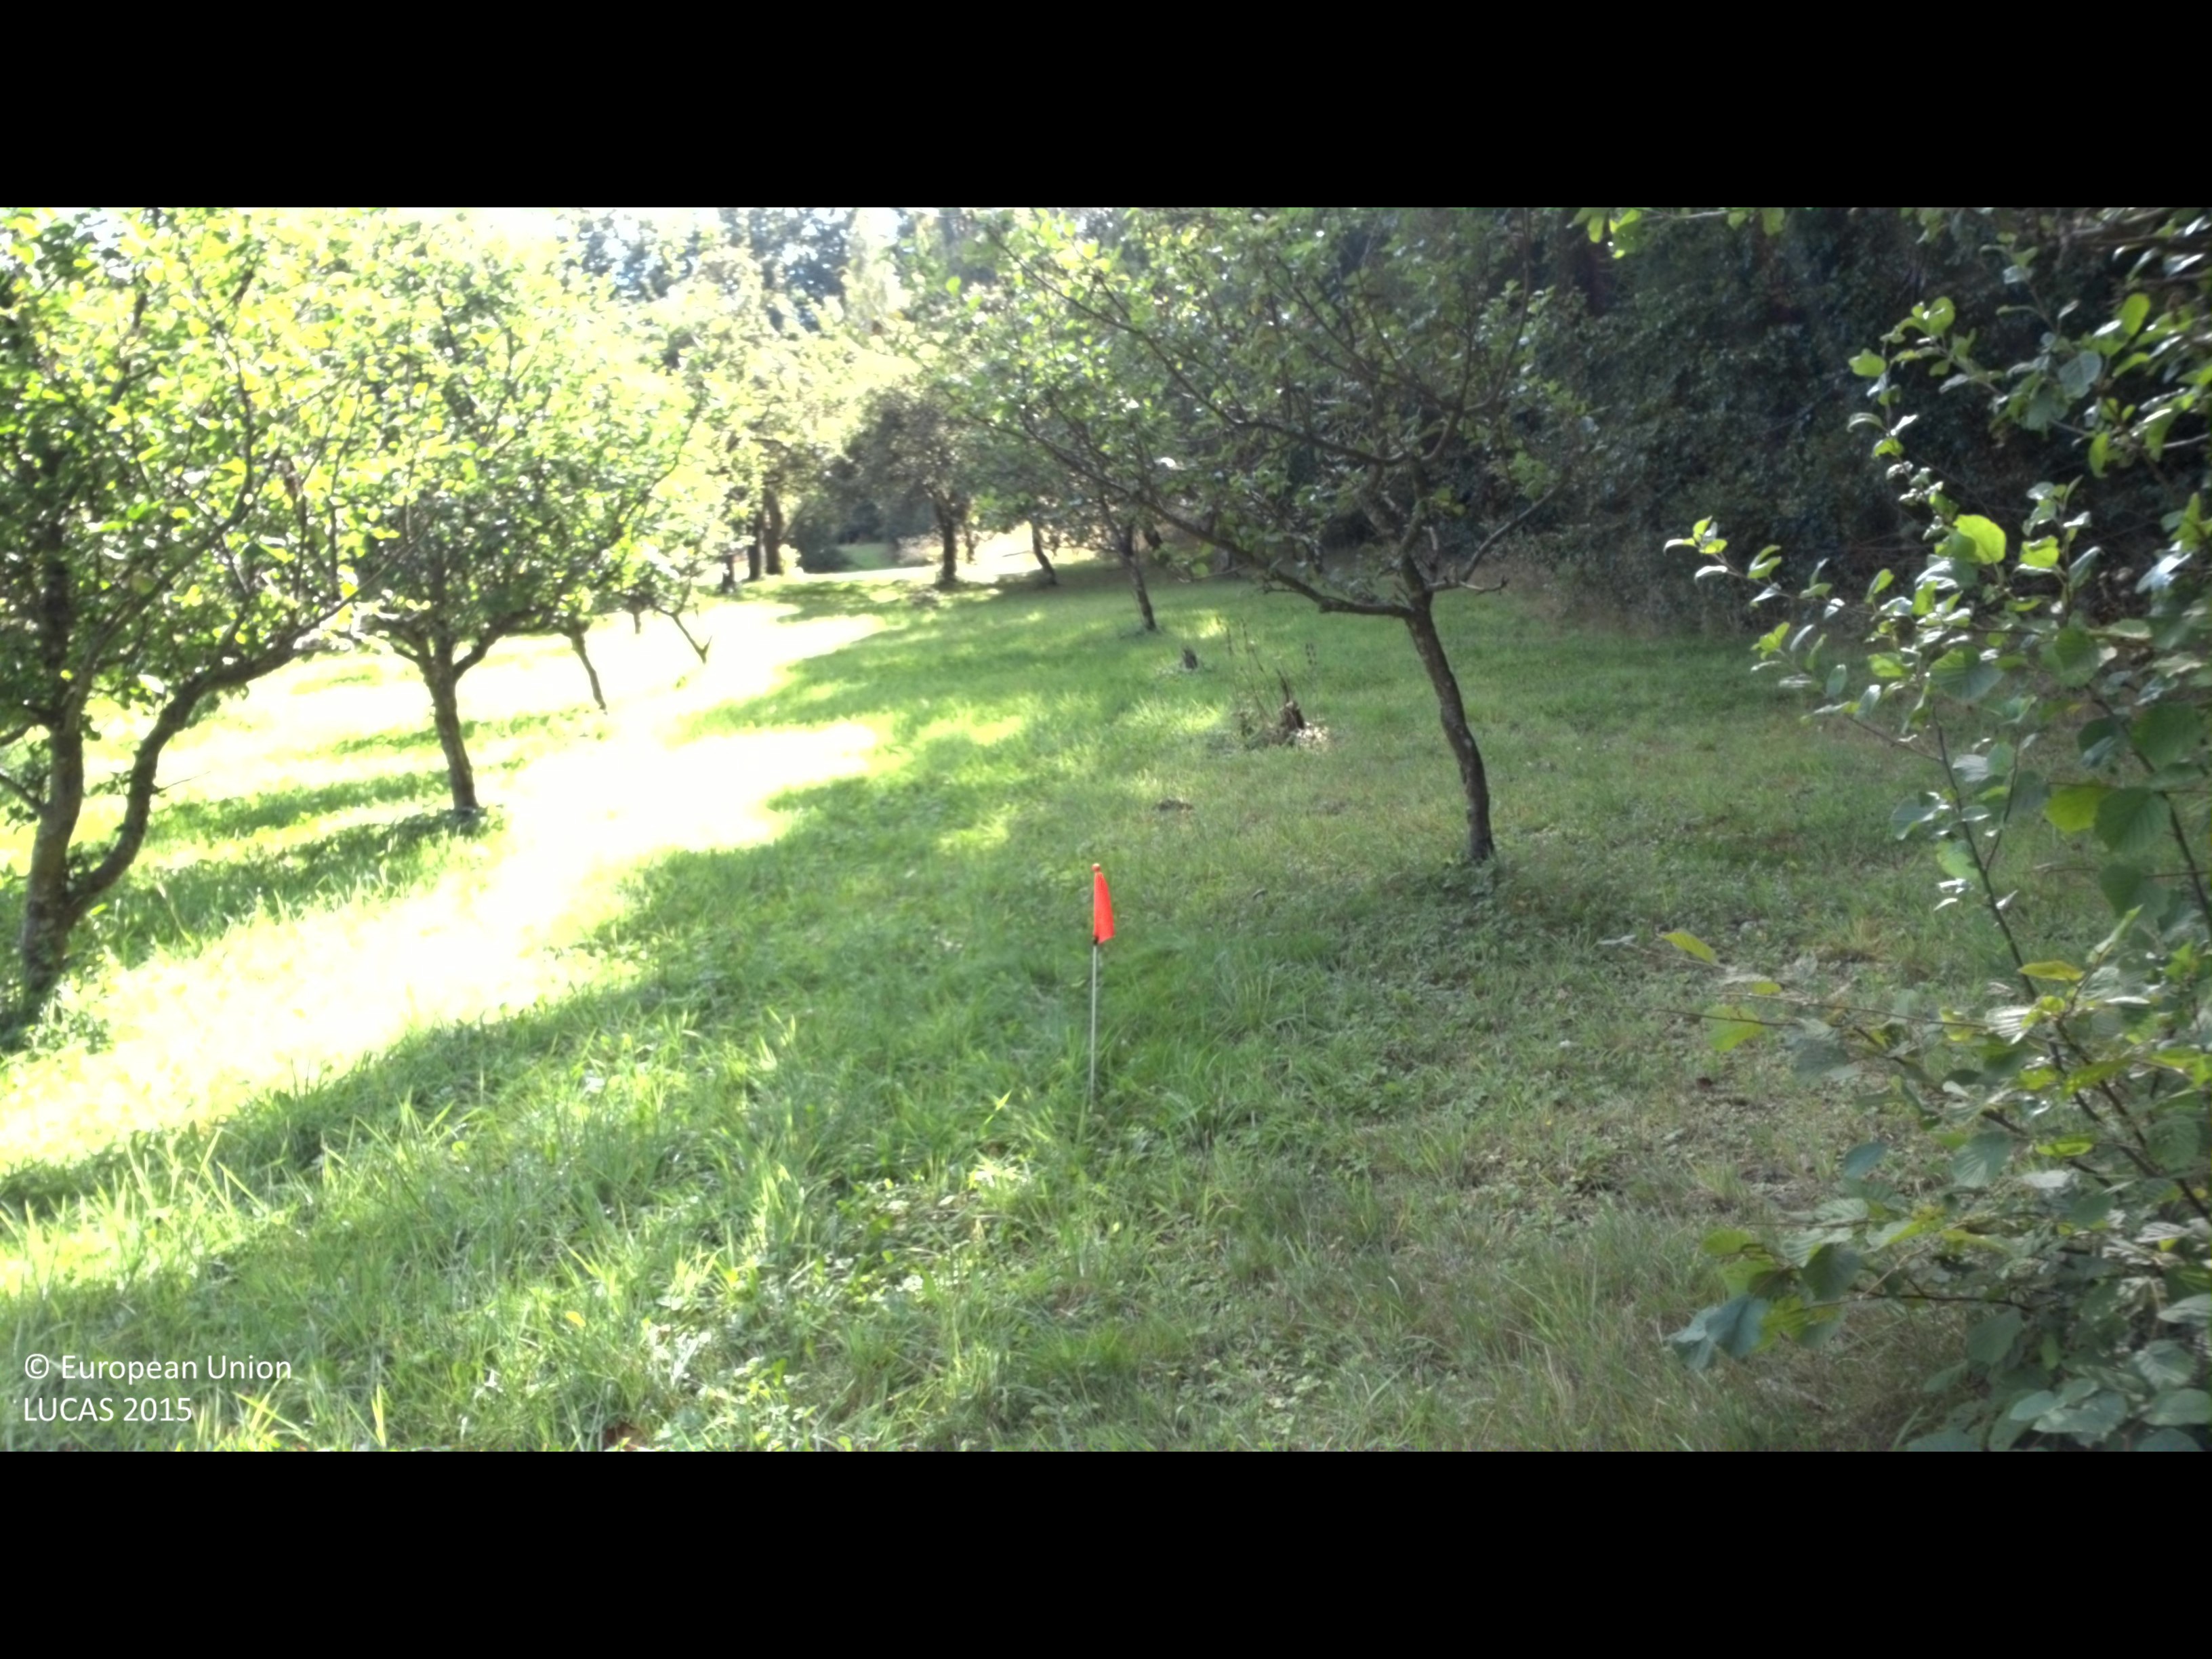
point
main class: Cropland
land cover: Apple fruit
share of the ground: 25 - 50 %
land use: Kitchen garden
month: September
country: SE
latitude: 56.1644
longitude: 14.4586
